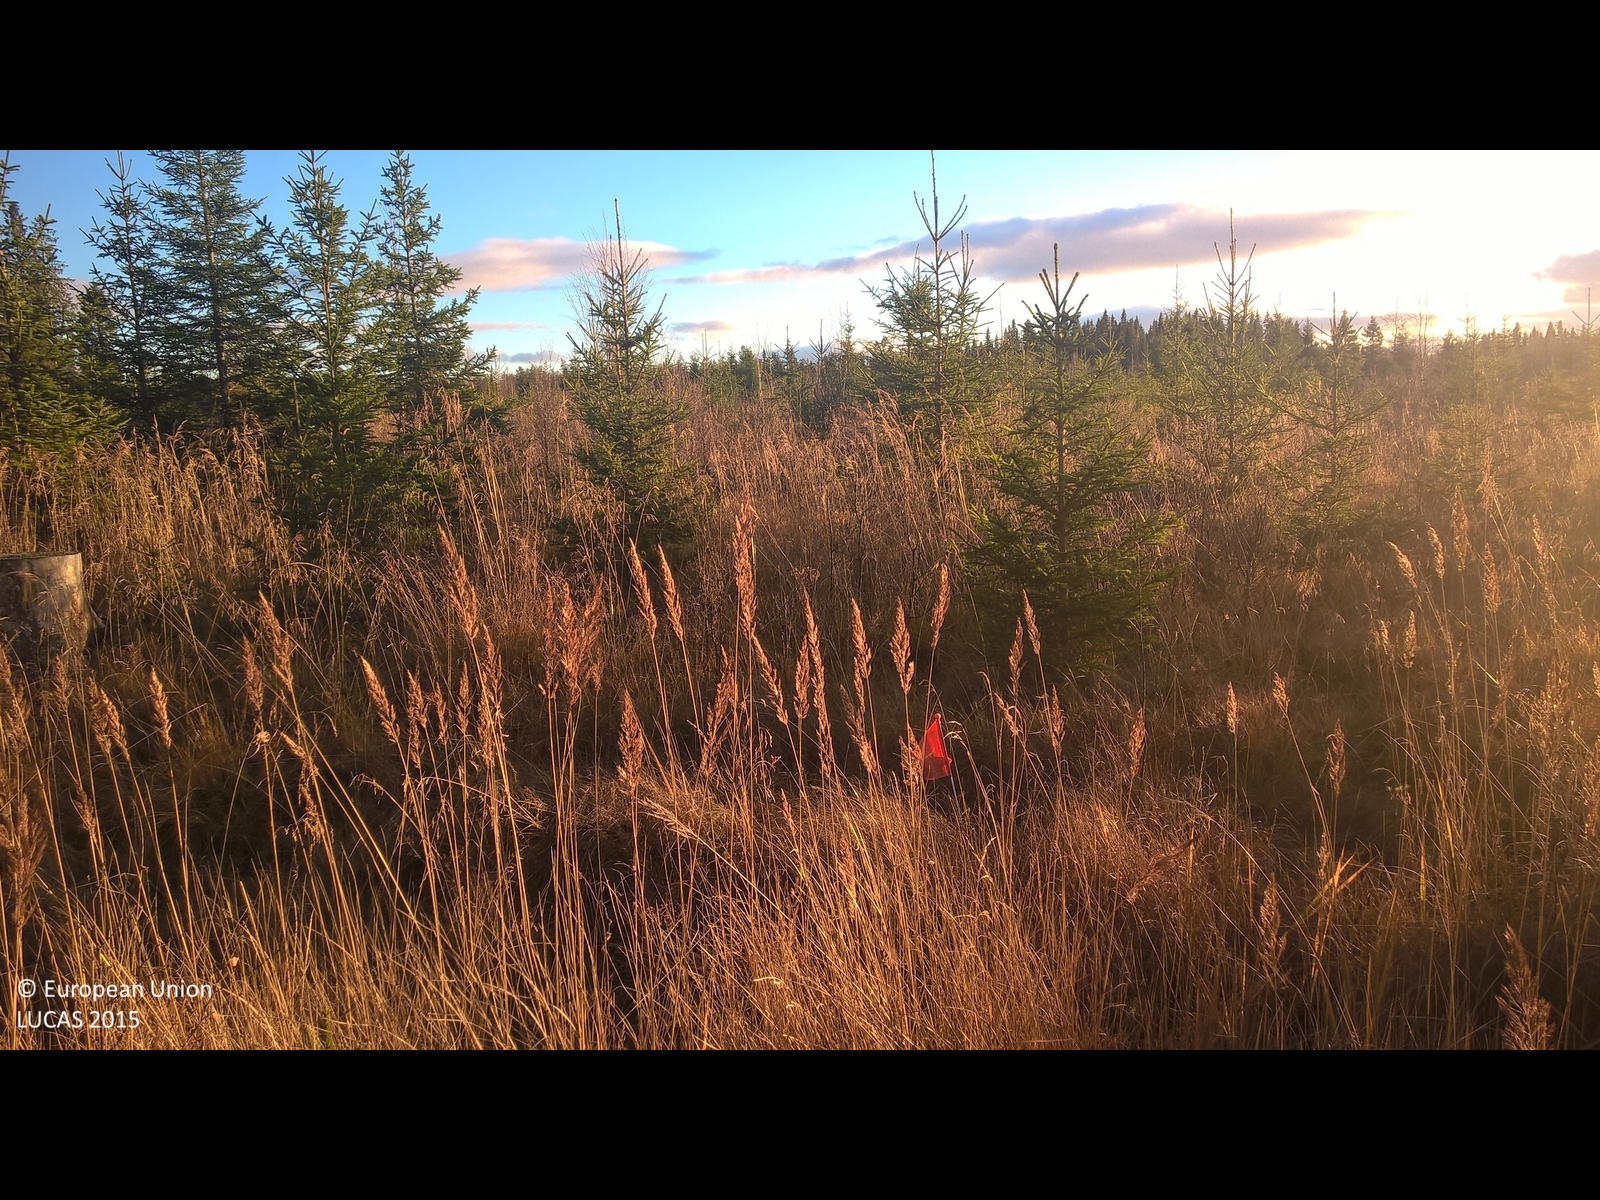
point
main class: Woodland
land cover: Spruce dominated coniferous woodland
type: boreal forest
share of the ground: 25 - 50 %
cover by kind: herbaceous plants 70 %, coniferous forest trees 20 %, broadleaved forest trees 5 %, shrubs 5 %
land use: Forestry
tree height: < 5 m
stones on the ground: < 10 %
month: November
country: SE
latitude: 63.0326
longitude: 14.5060
